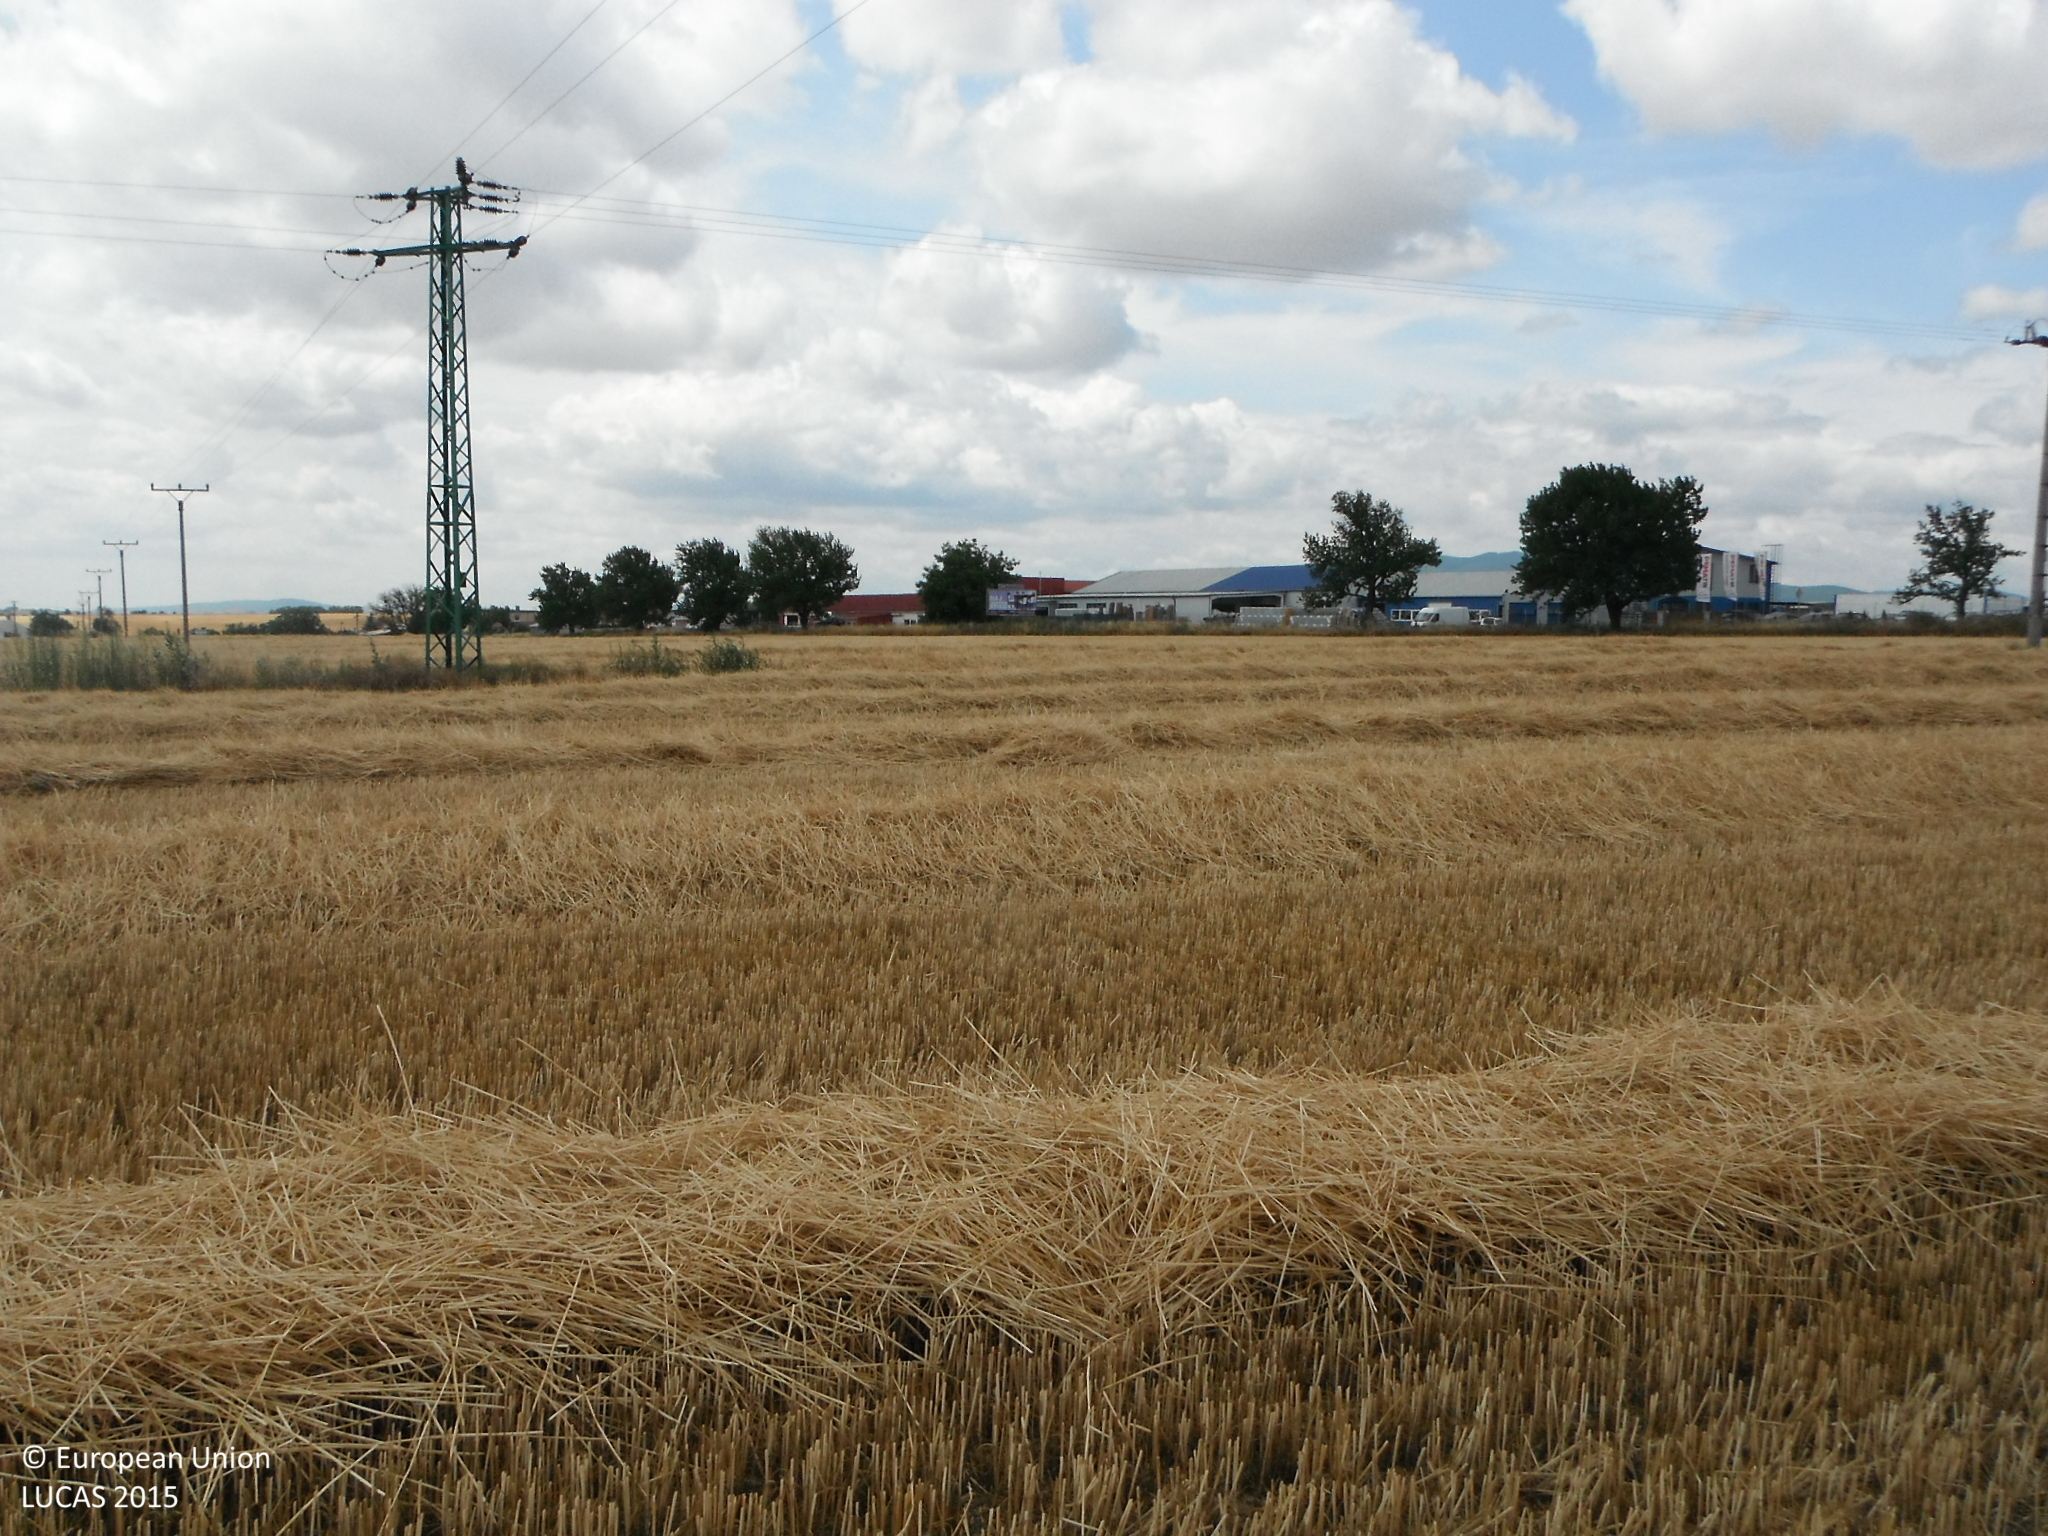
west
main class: Cropland
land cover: Common wheat
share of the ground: > 75 %
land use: Agriculture (excluding fallow land and kitchen gardens)
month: July
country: SK
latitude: 48.5558
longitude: 18.1301
